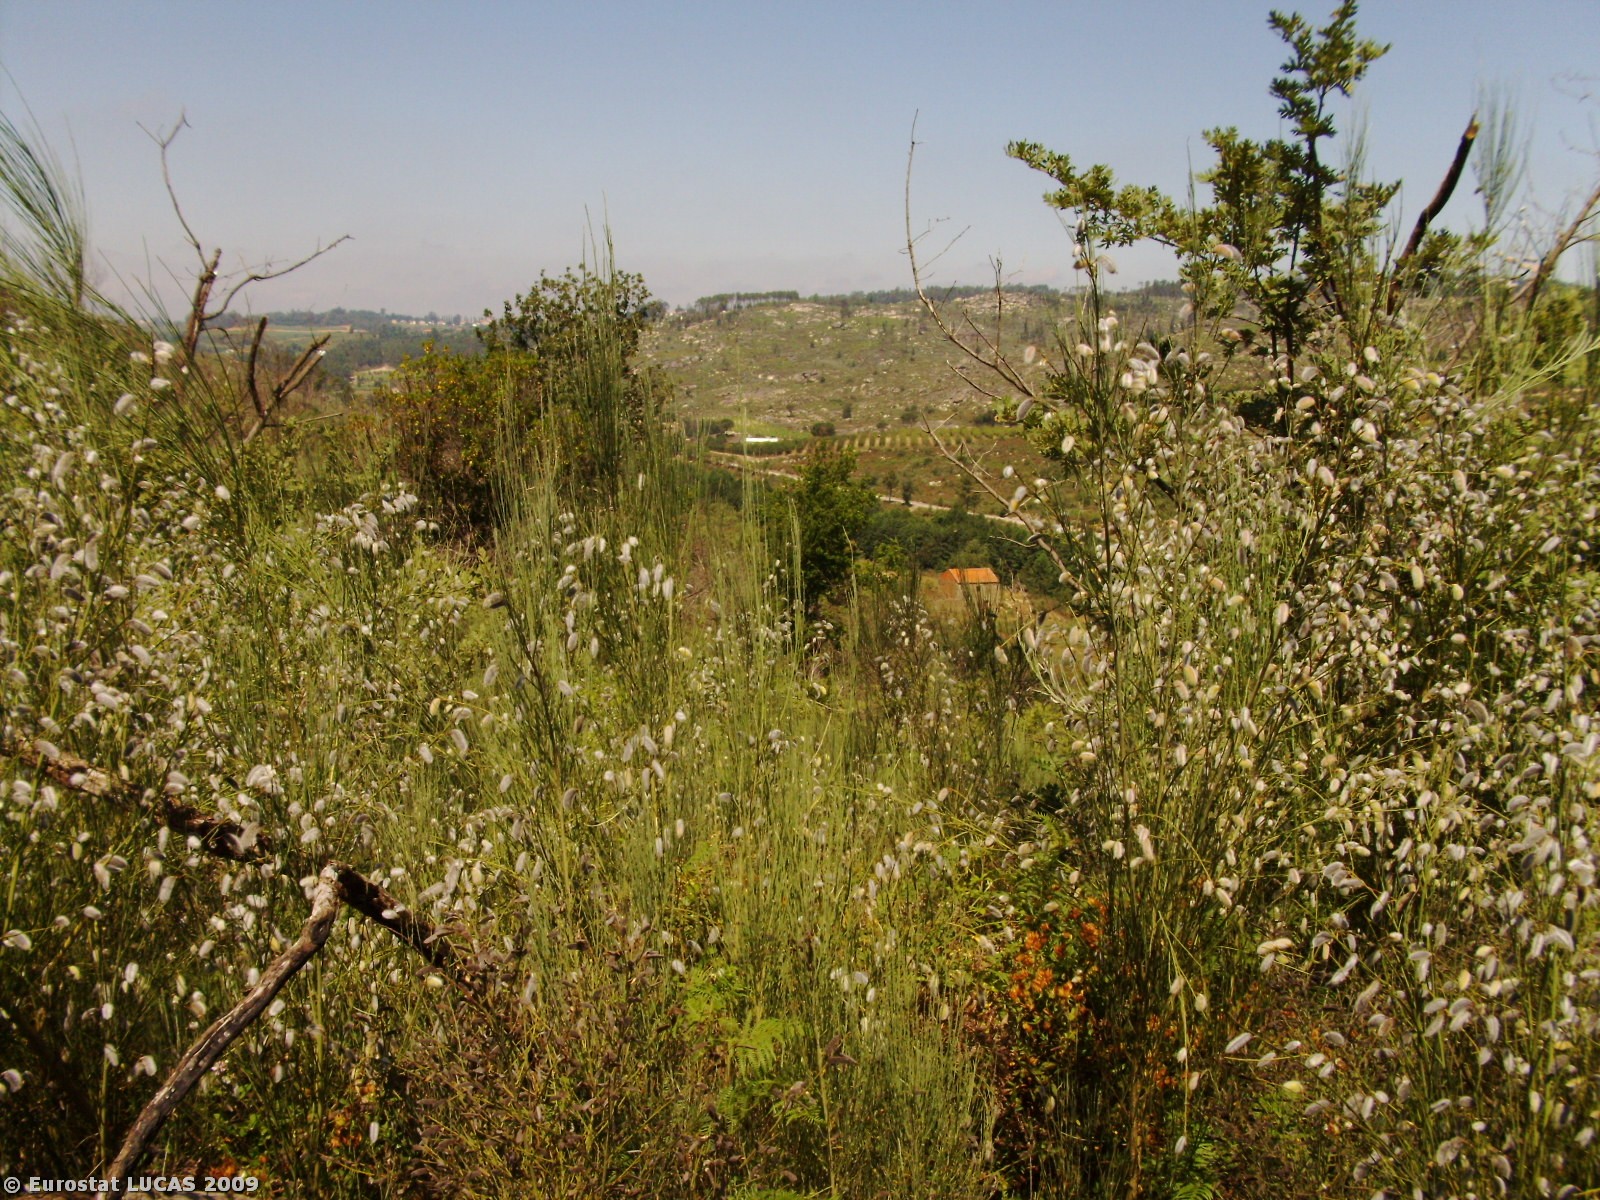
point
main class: Woodland
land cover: Broadleaved woodland
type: mesophytic deciduous forest
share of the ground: 10 - 25 %
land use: Forestry
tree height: > 5 m
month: July
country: PT
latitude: 40.6634
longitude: -7.6595
